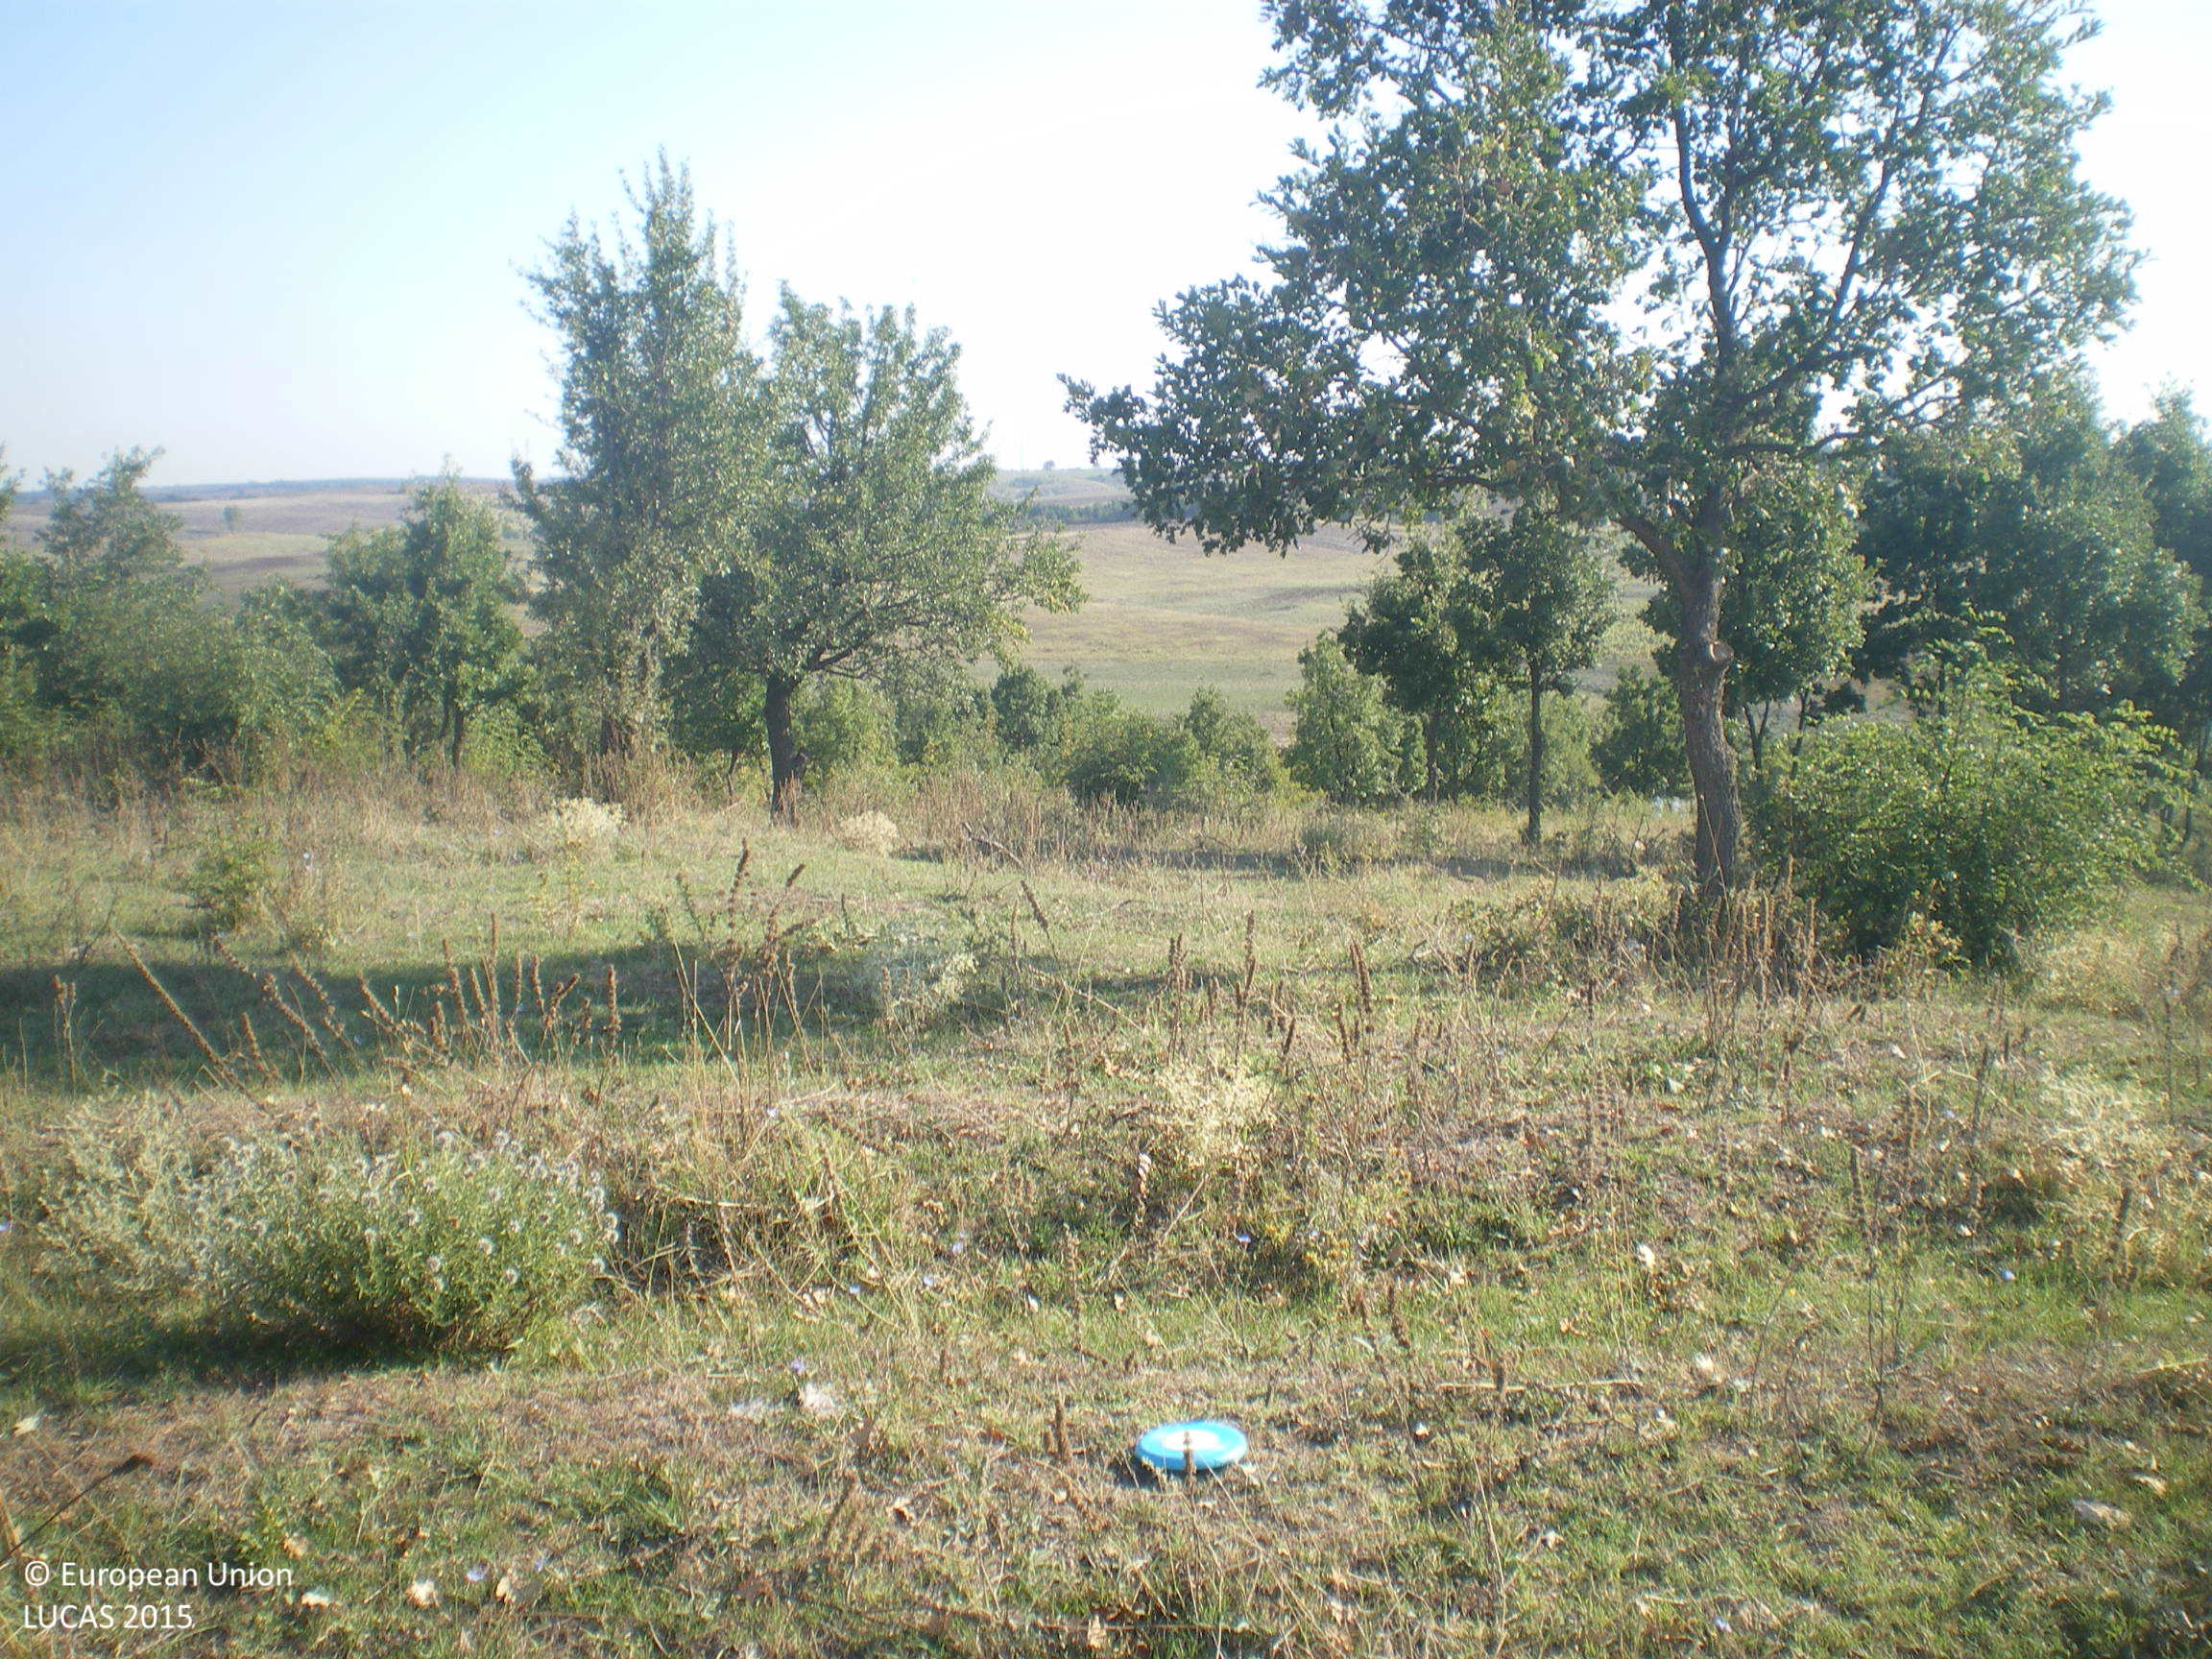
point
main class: Grassland
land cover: Grassland with sparse tree/shrub cover
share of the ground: > 75 %
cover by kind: herbaceous plants 85 %, shrubs 10 %, broadleaved forest trees 5 %
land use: Agriculture (excluding fallow land and kitchen gardens)
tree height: > 5 m
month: August
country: BG
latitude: 42.0619
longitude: 25.9409
